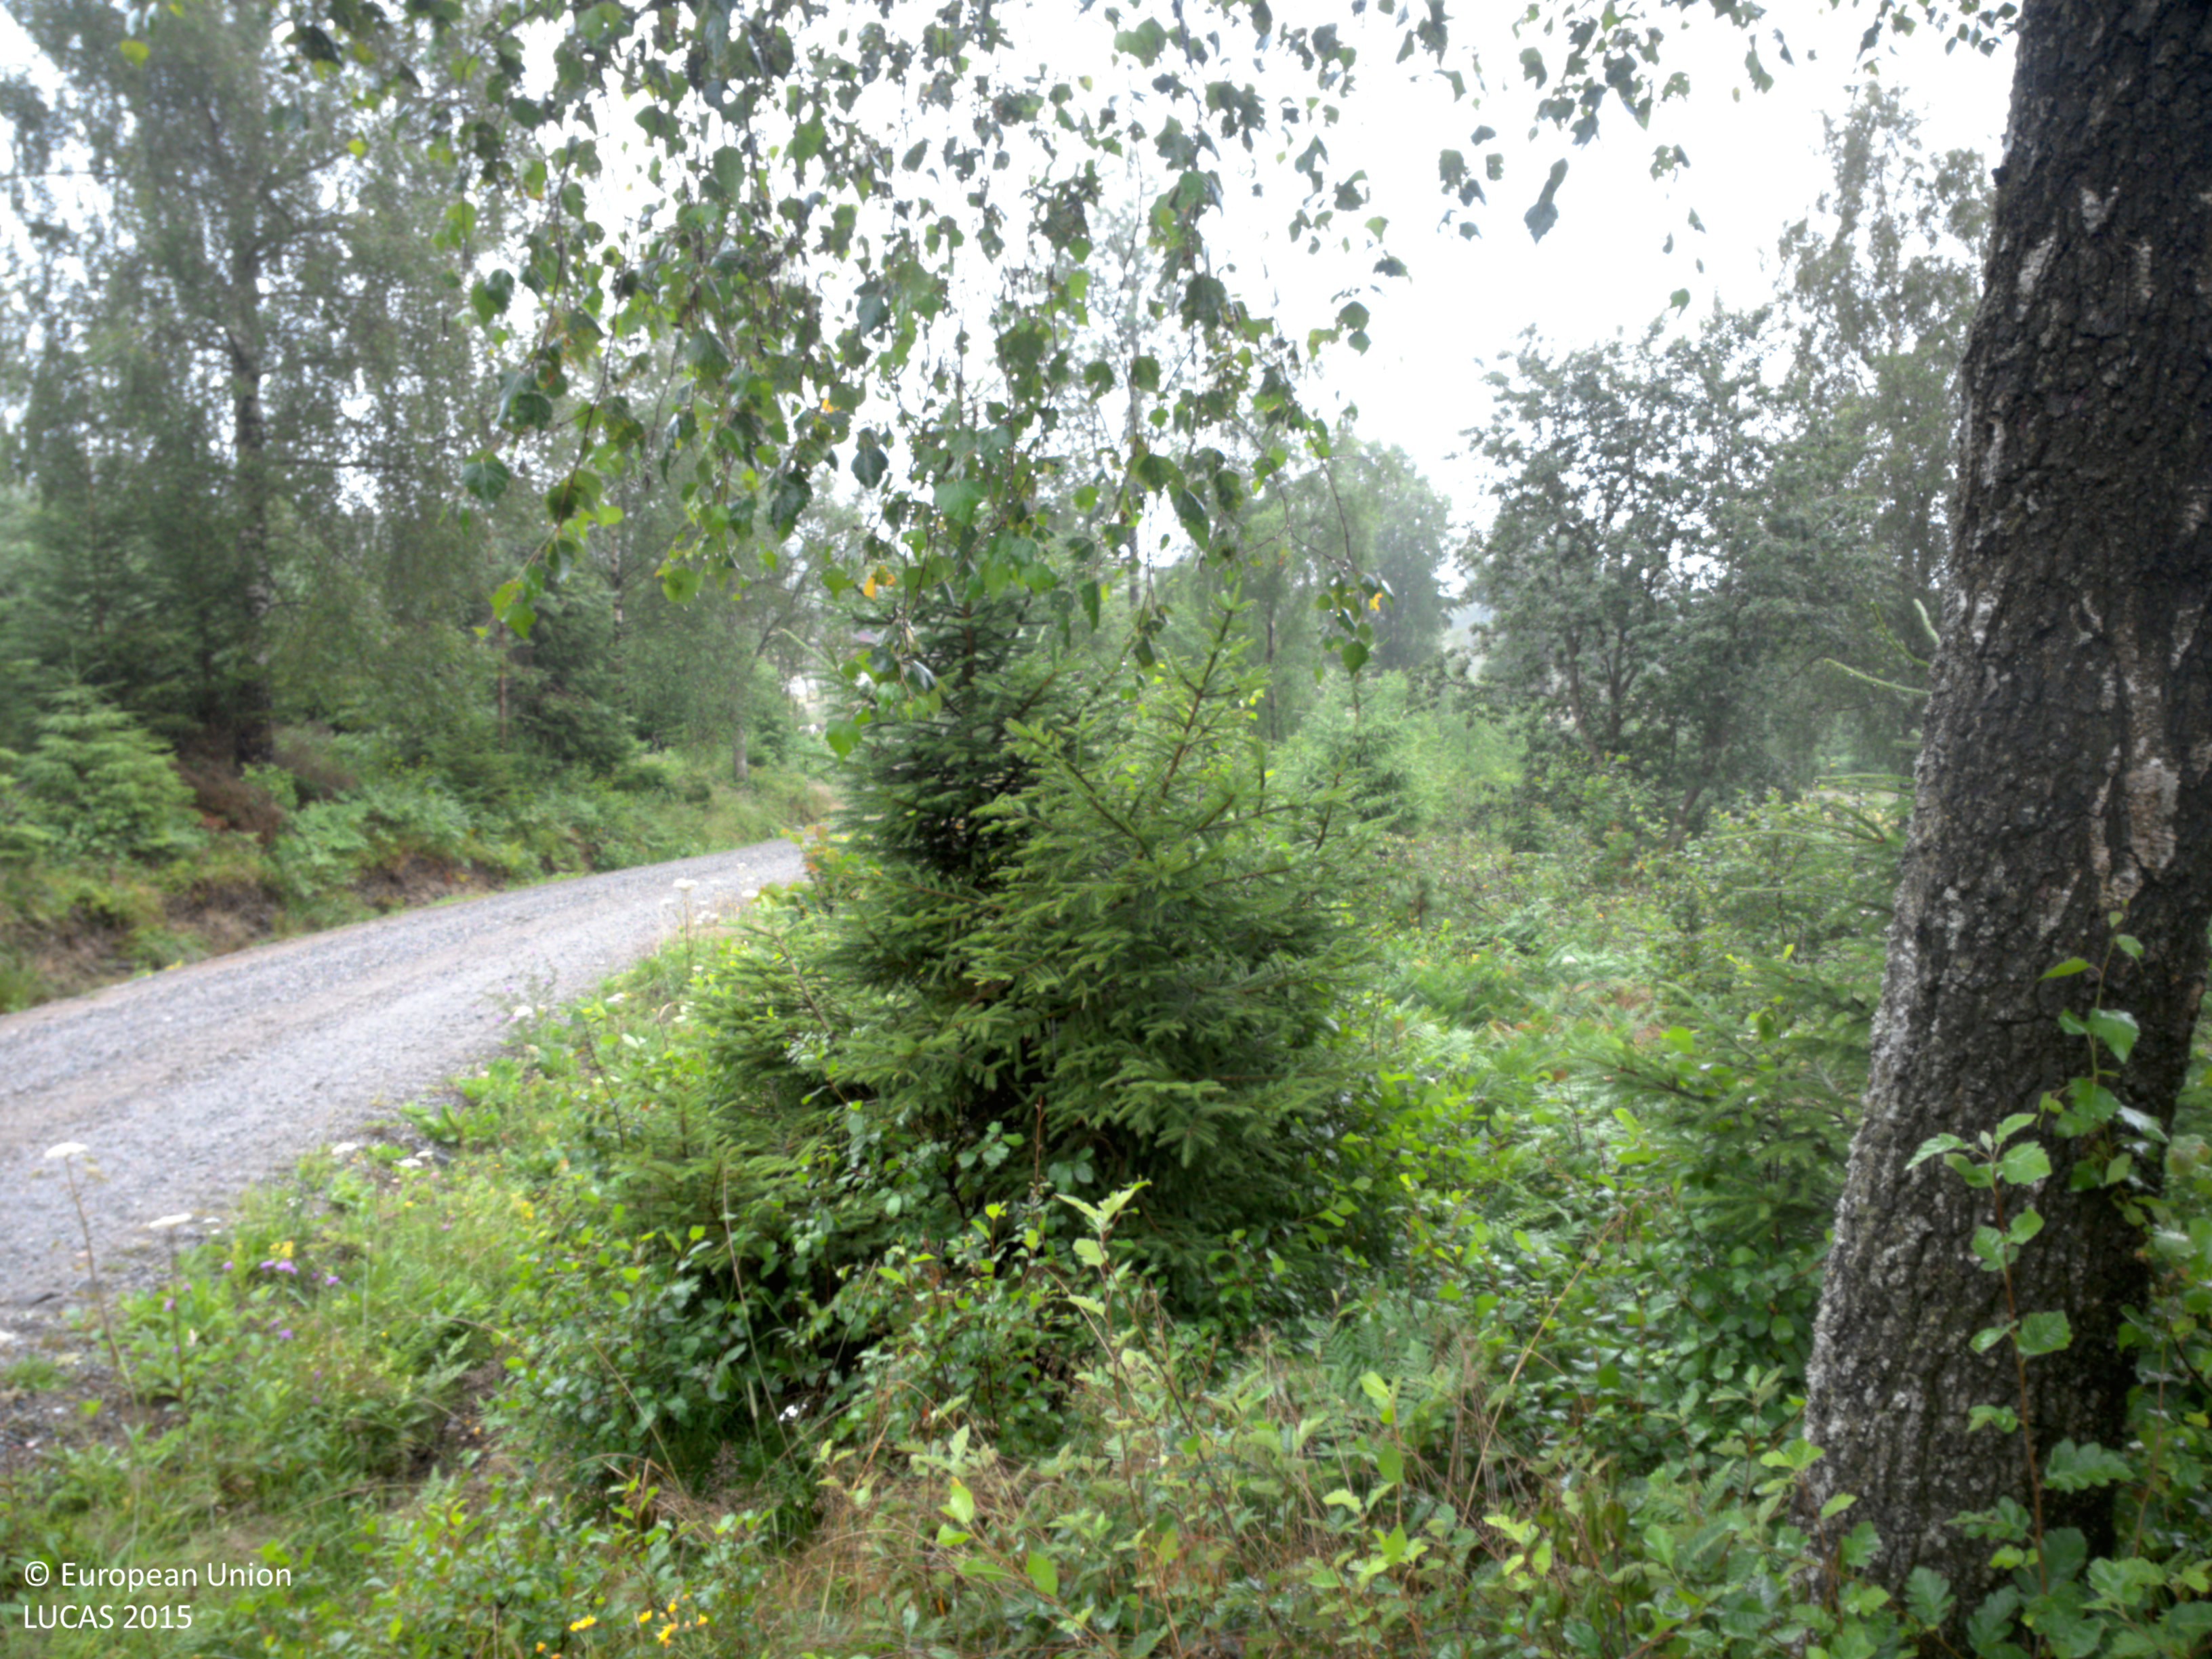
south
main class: Woodland
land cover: Spruce dominated mixed woodland
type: boreal forest
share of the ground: 50 - 75 %
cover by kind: coniferous forest trees 30 %, broadleaved forest trees 30 %, herbaceous plants 30 %, shrubs 10 %
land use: Forestry
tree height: > 5 m
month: July
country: SE
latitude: 58.6751
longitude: 11.8068
